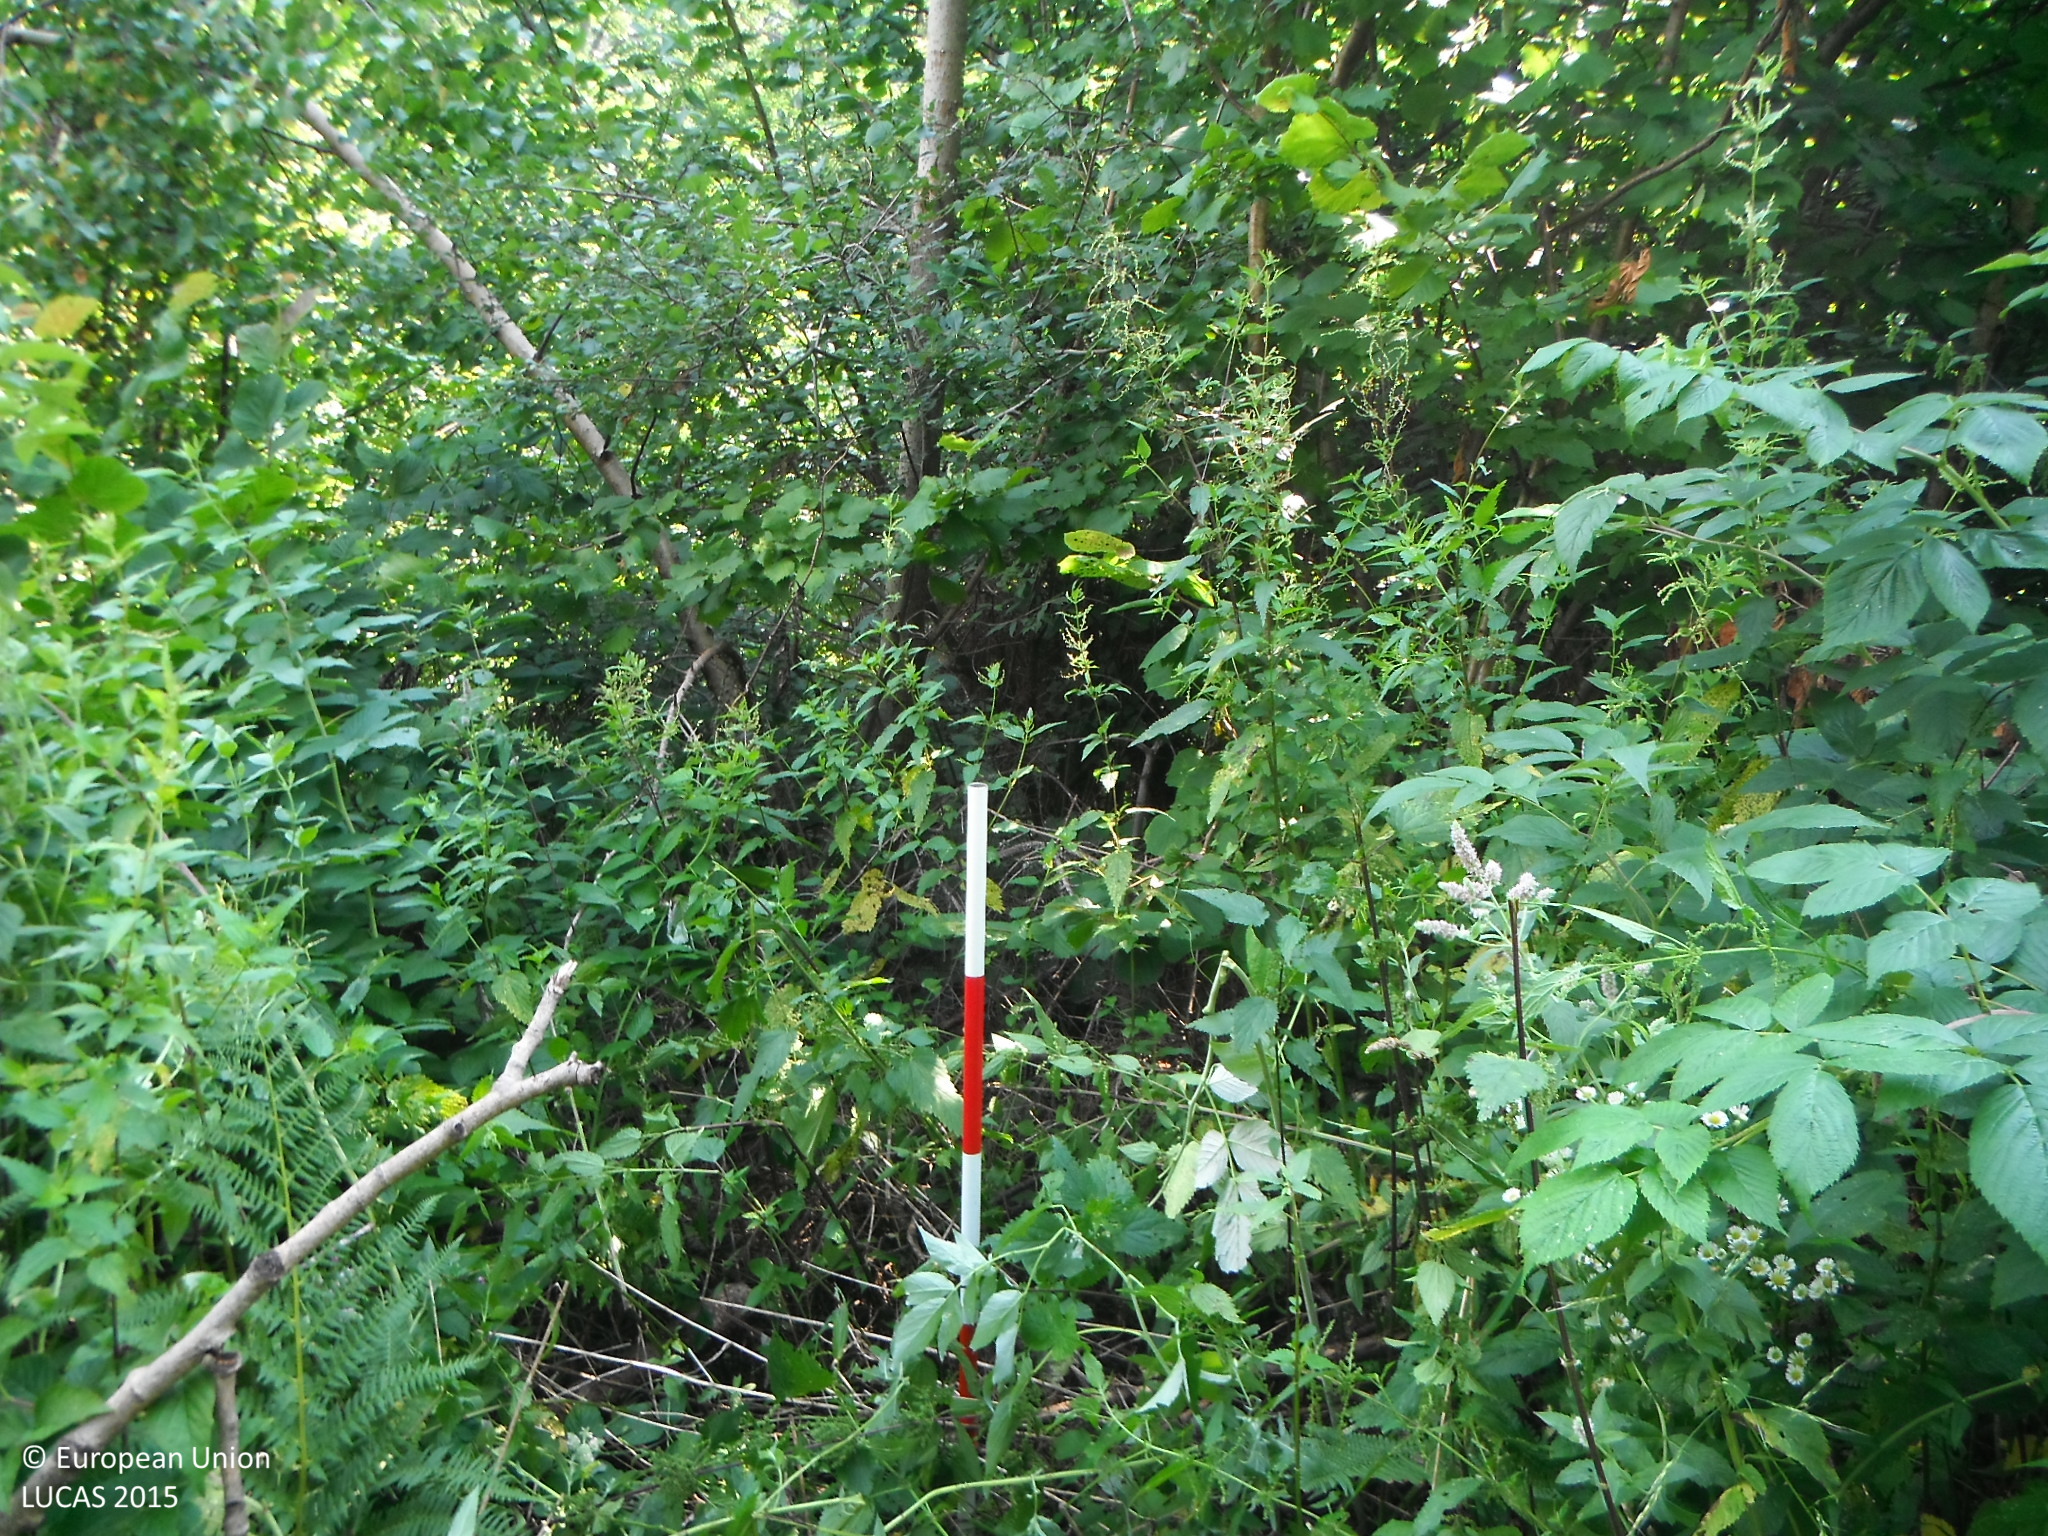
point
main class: Shrubland
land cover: Shrubland with sparse tree cover
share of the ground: > 75 %
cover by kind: shrubs 95 %, broadleaved forest trees 5 %
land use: Semi-natural and natural areas not in use
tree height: > 5 m
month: August
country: SK
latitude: 48.7424
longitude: 20.2453
